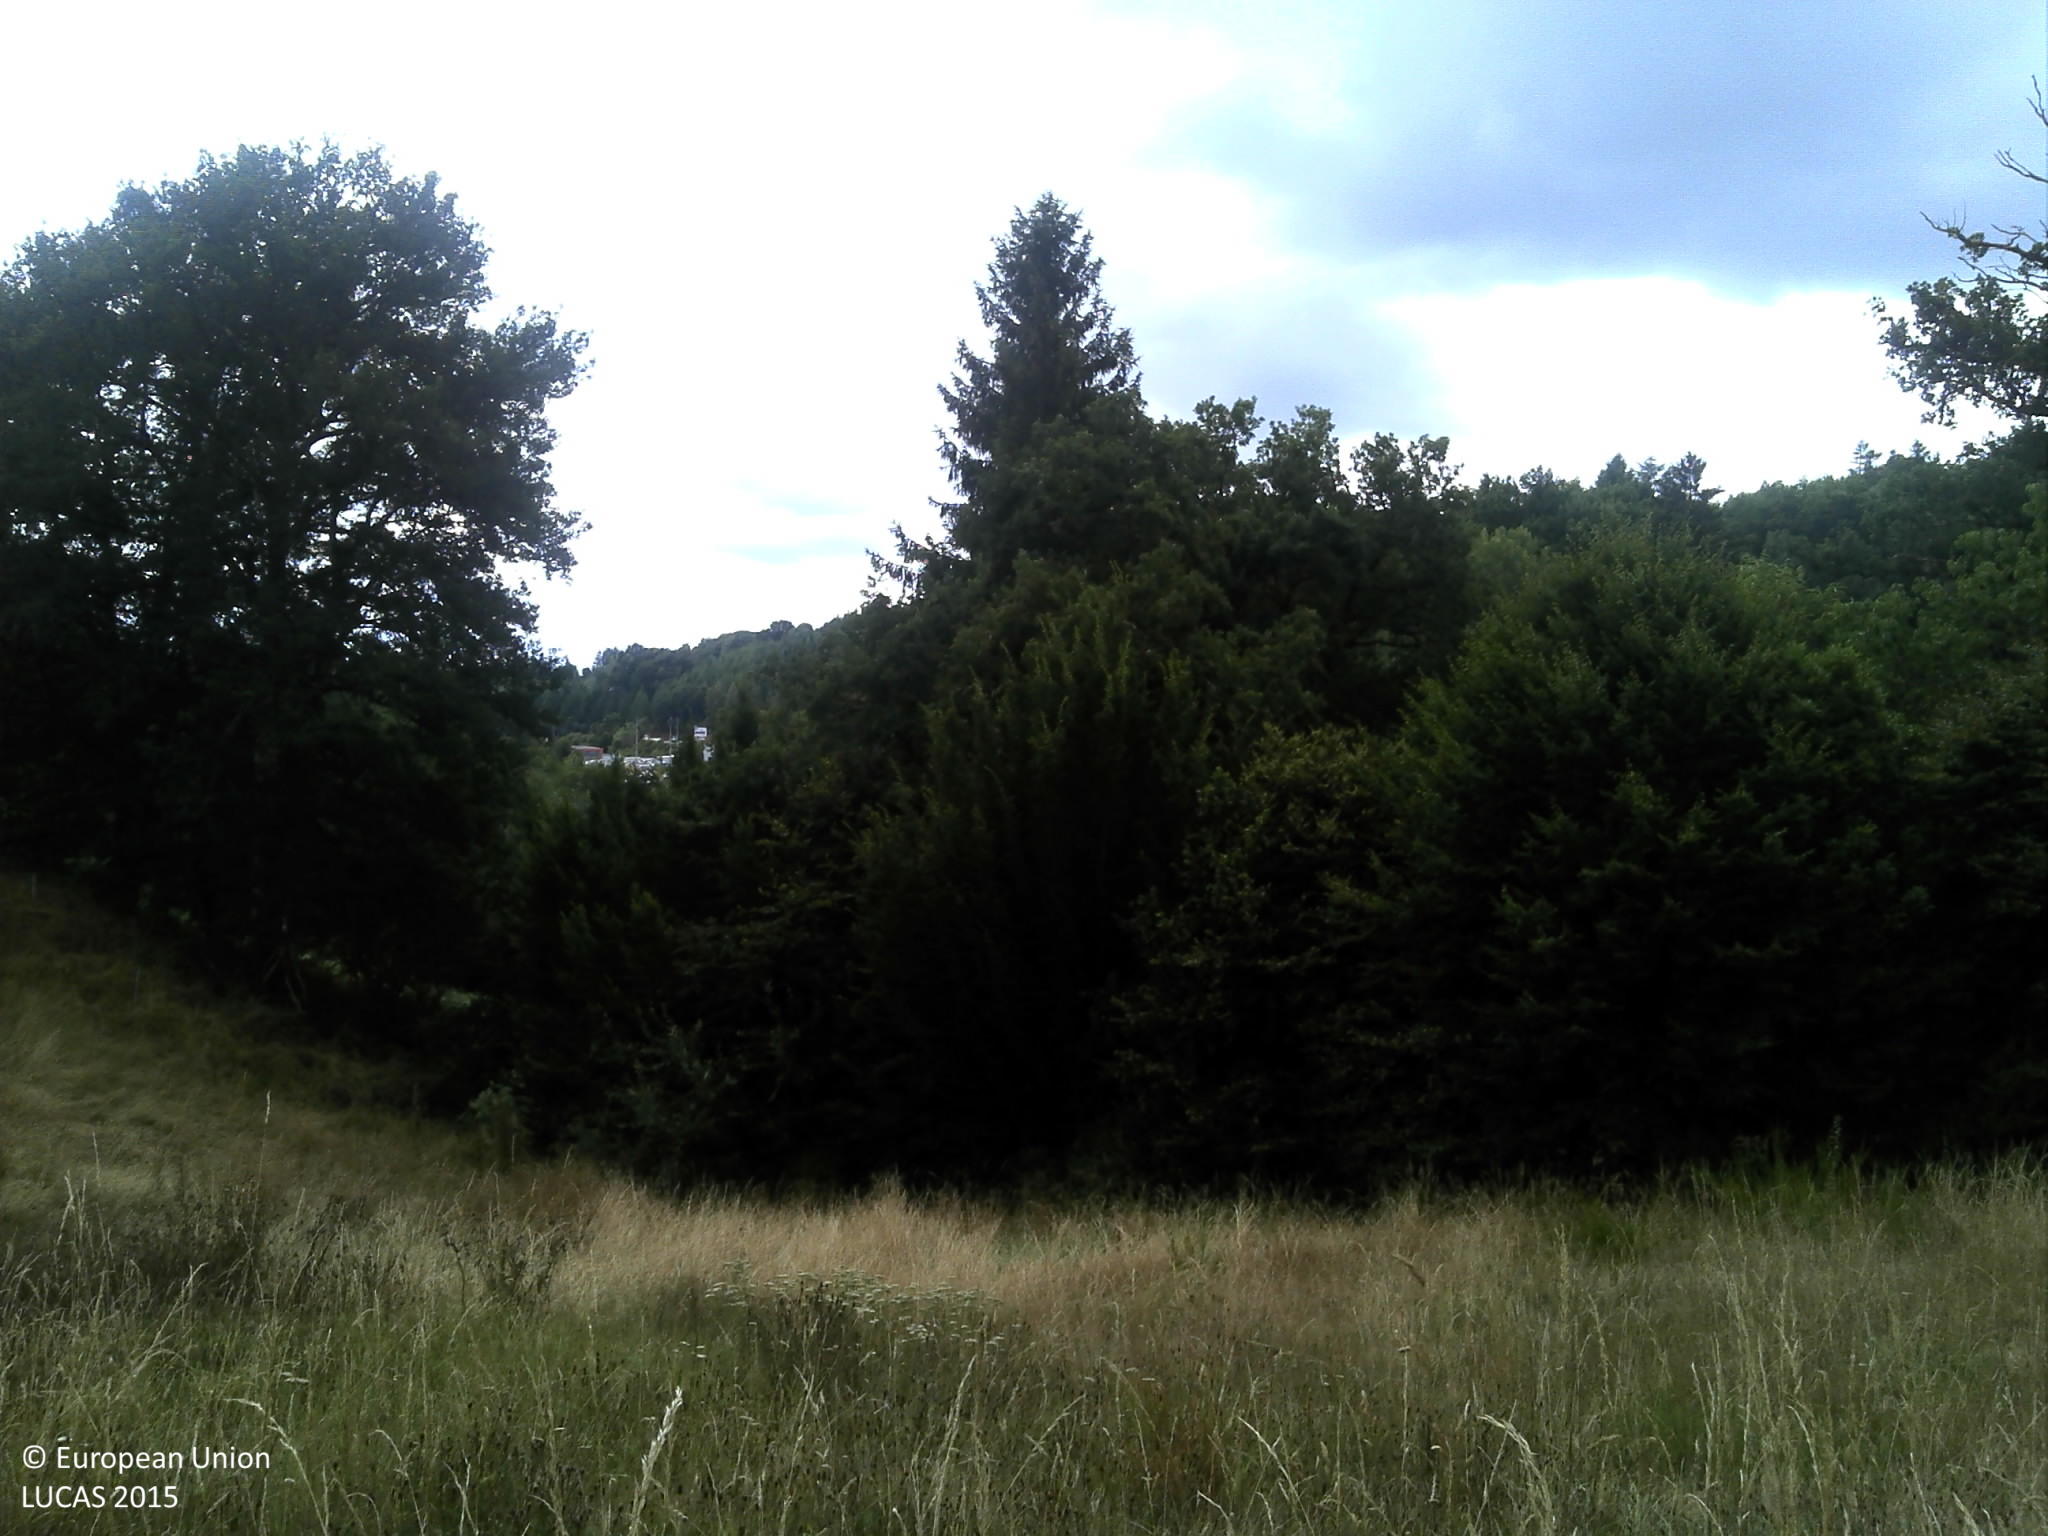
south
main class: Grassland
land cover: Grassland with sparse tree/shrub cover
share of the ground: > 75 %
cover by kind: herbaceous plants 95 %, broadleaved forest trees 5 %
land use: Agriculture (excluding fallow land and kitchen gardens)
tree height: > 5 m
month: August
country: FR
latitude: 45.5487
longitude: 2.2994
